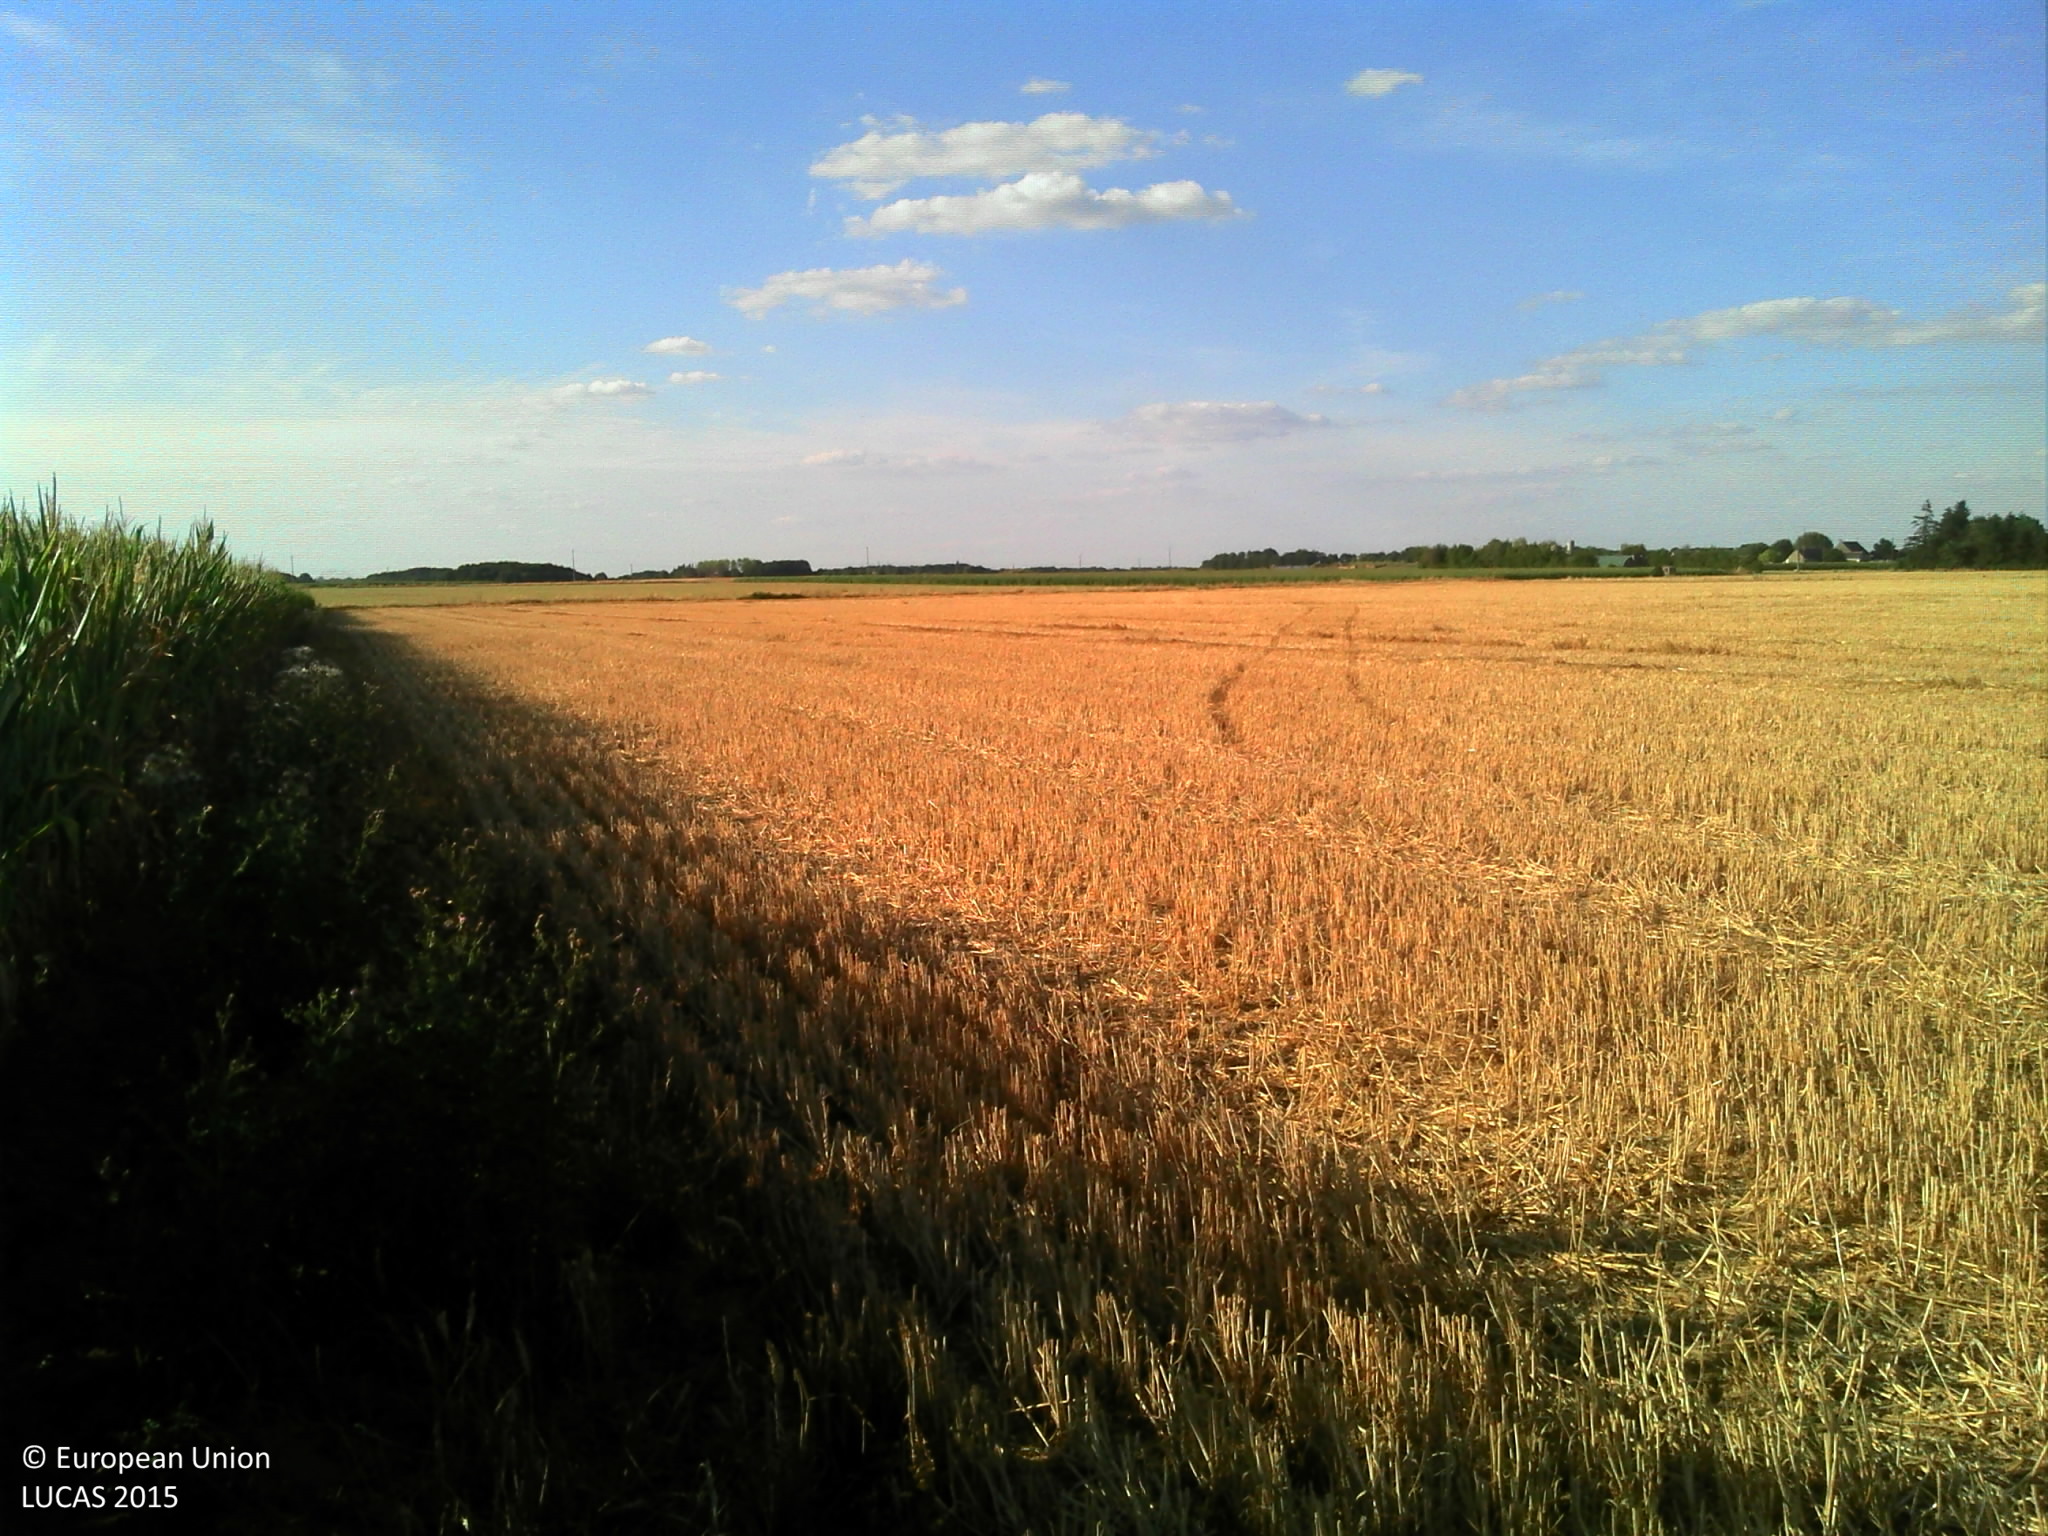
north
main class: Cropland
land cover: Maize
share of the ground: > 75 %
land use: Agriculture (excluding fallow land and kitchen gardens)
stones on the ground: < 10 %
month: July
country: FR
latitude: 47.1803
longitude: 0.7316
